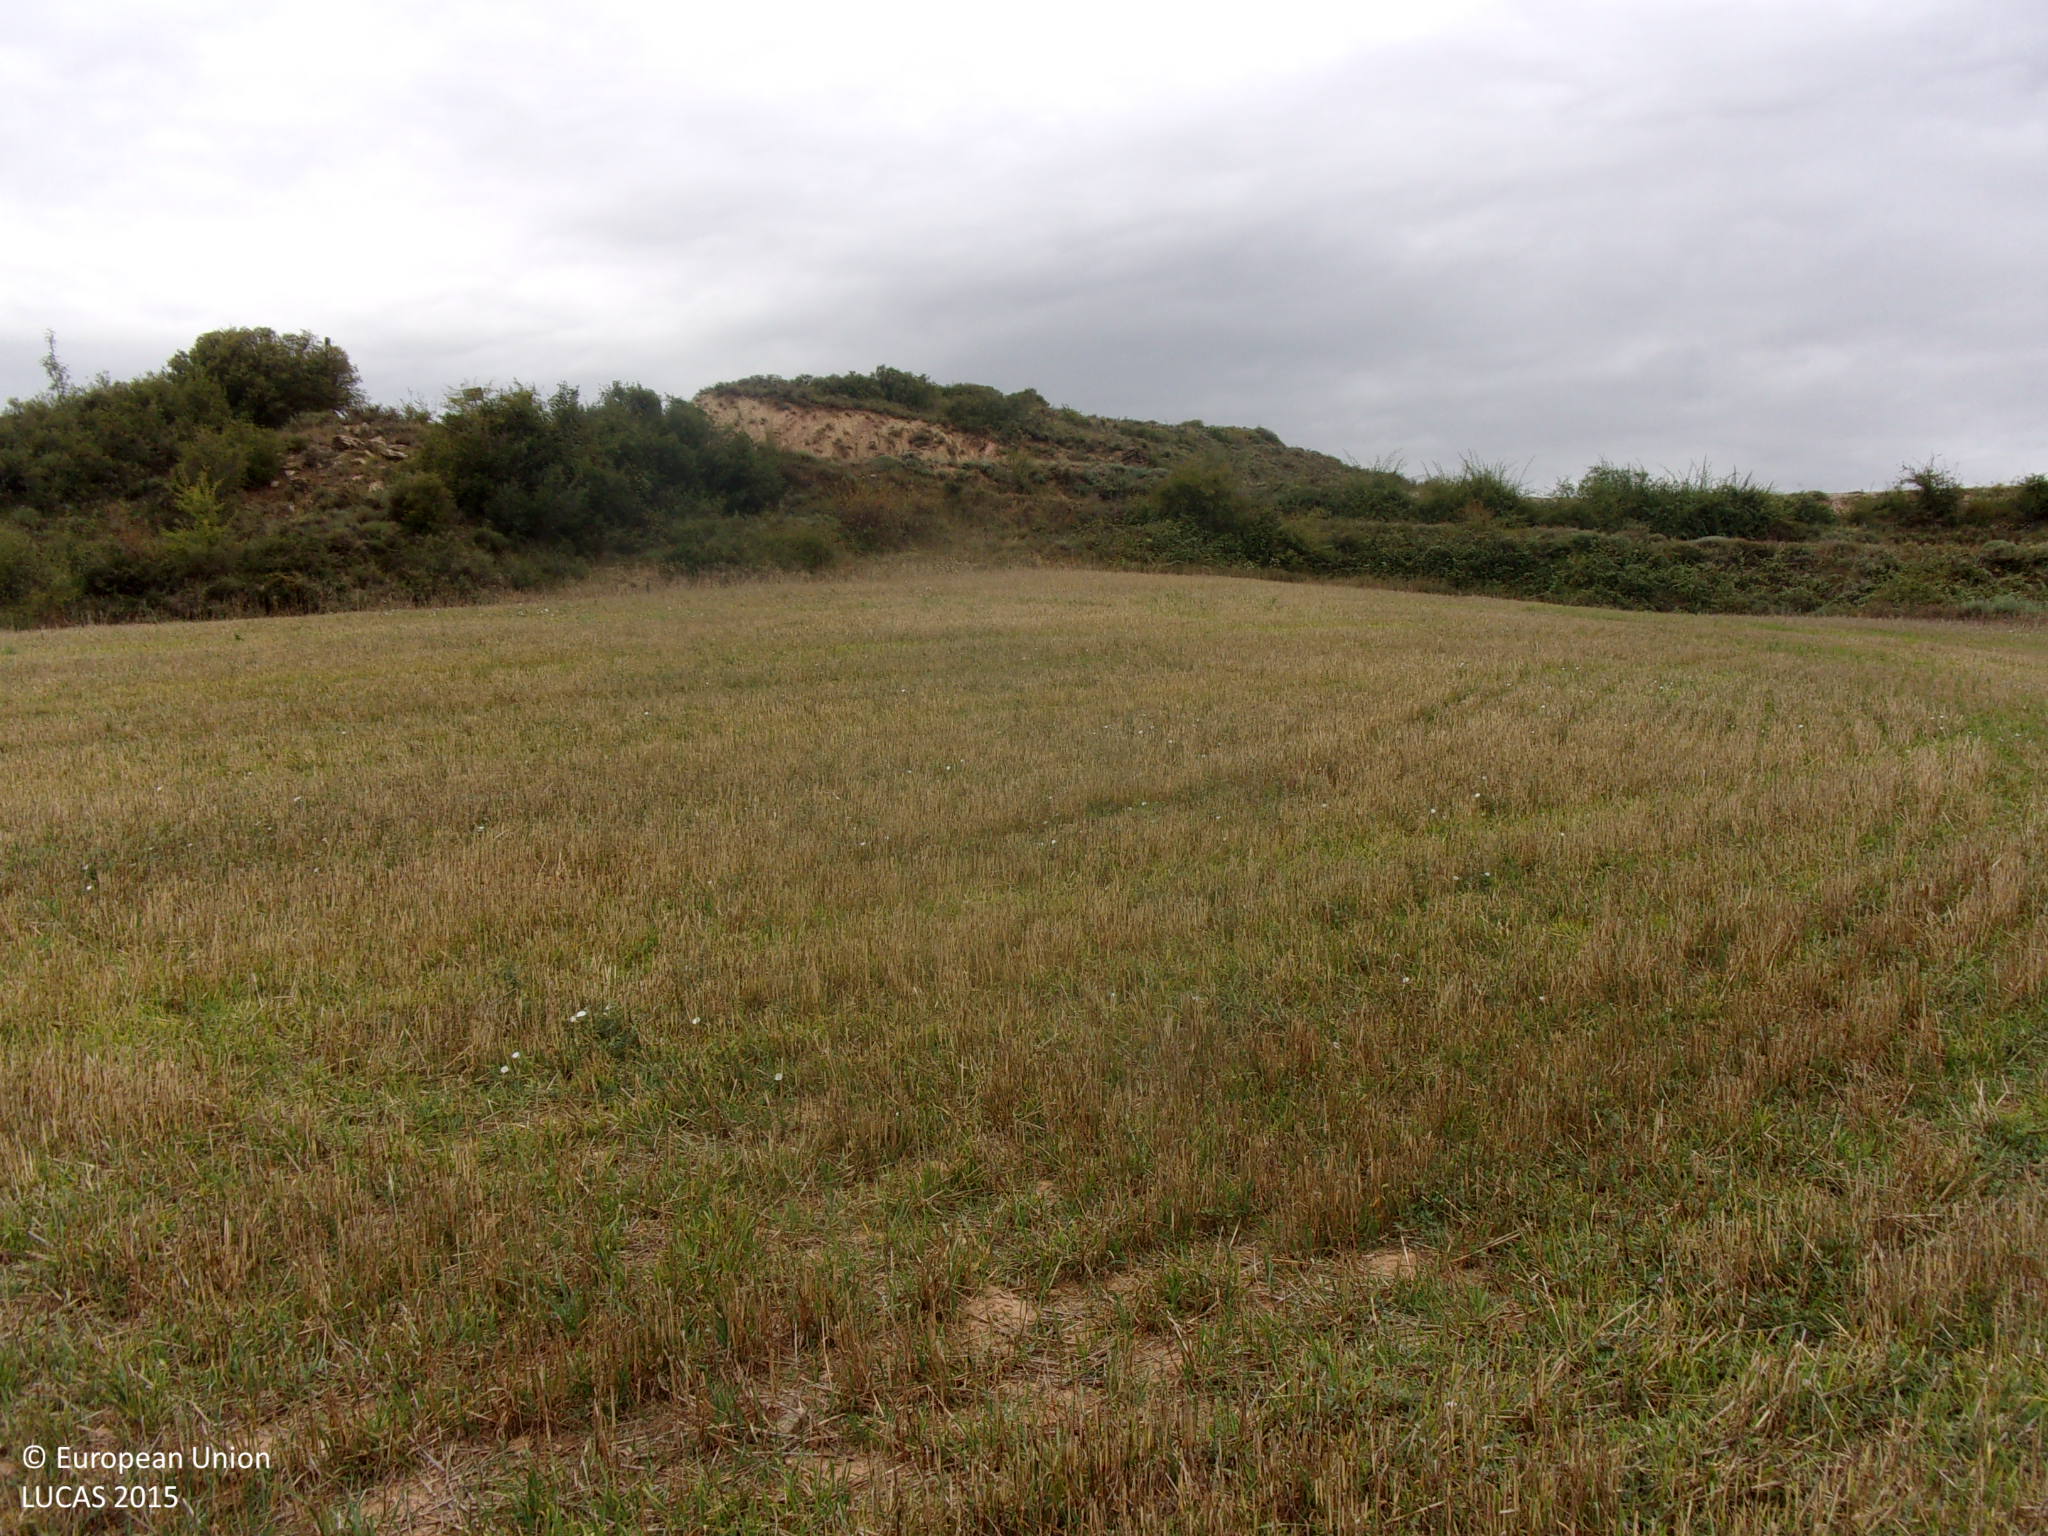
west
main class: Cropland
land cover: Barley
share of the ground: < 10 %
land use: Agriculture (excluding fallow land and kitchen gardens)
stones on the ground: < 10 %
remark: Harvested field
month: August
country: ES
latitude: 42.5312
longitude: -1.1226
